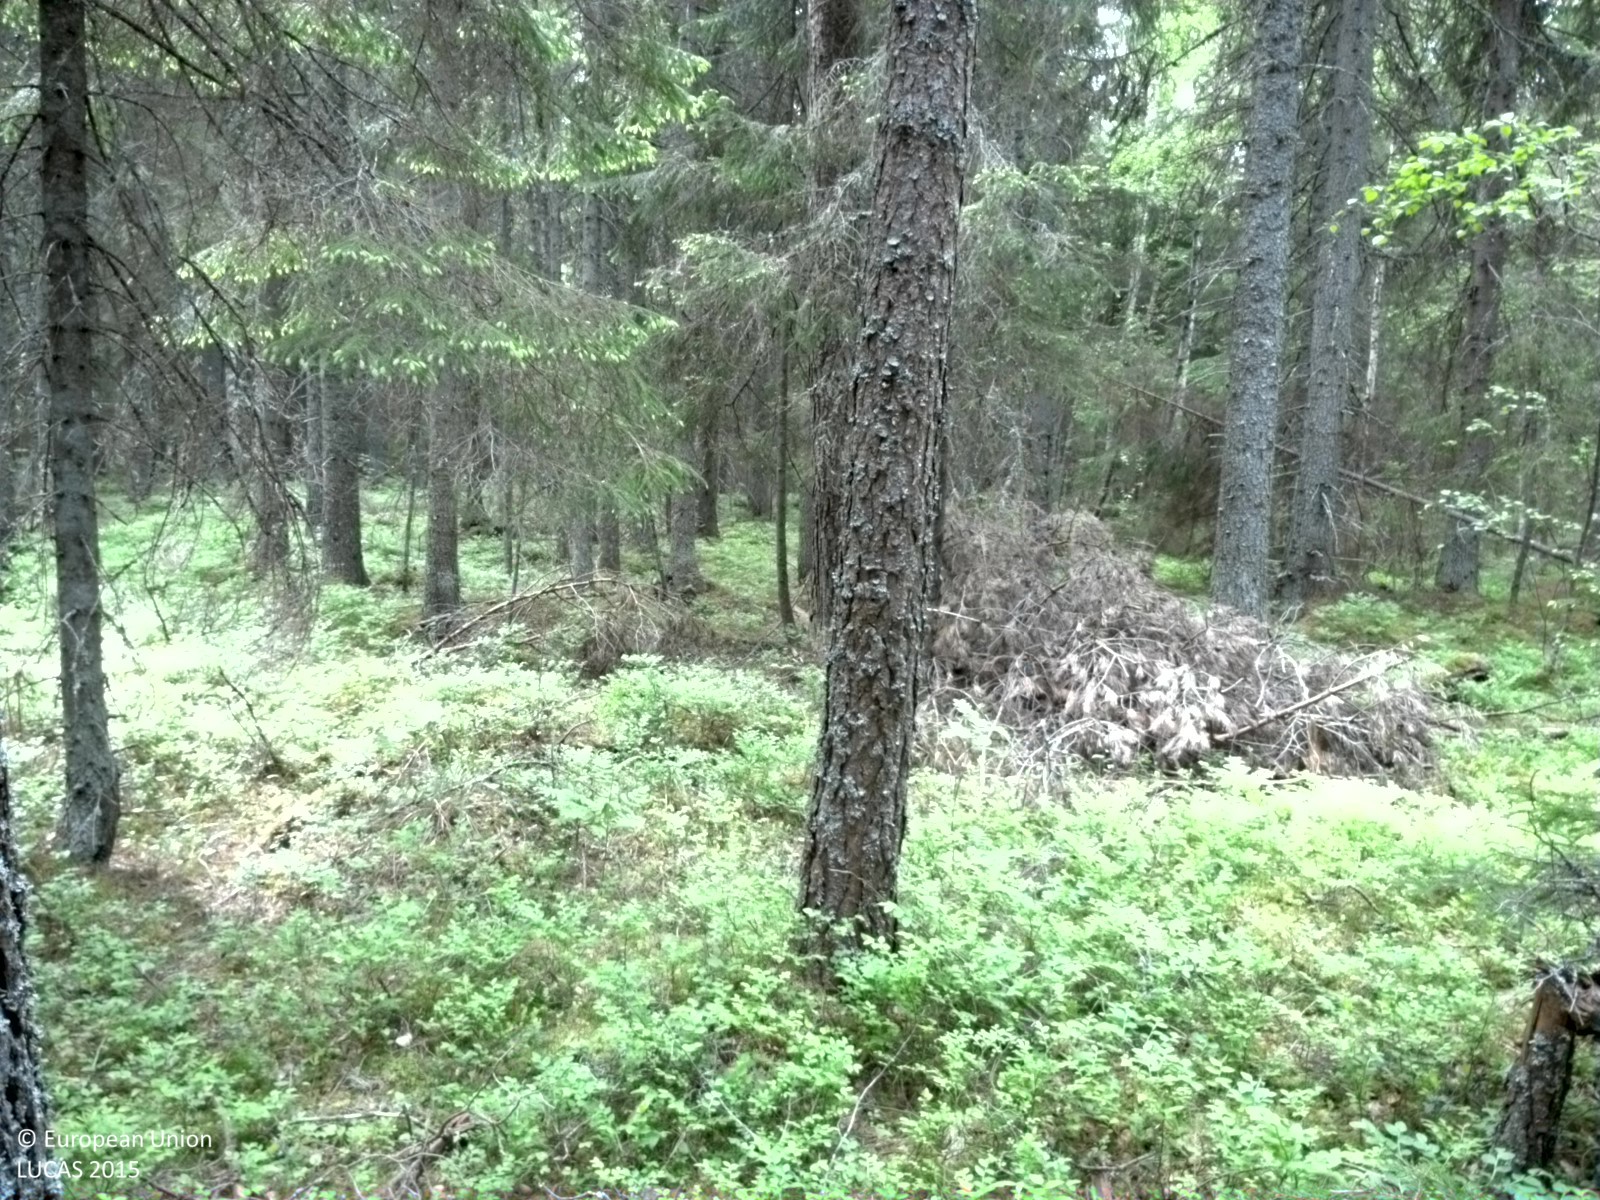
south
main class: Woodland
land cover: Spruce dominated coniferous woodland
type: boreal forest
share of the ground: > 75 %
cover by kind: coniferous forest trees 75 %, shrubs 10 %, lichens and mosses 10 %, broadleaved forest trees 5 %
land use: Forestry
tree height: > 5 m
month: June
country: SE
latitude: 60.2642
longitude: 17.2753
